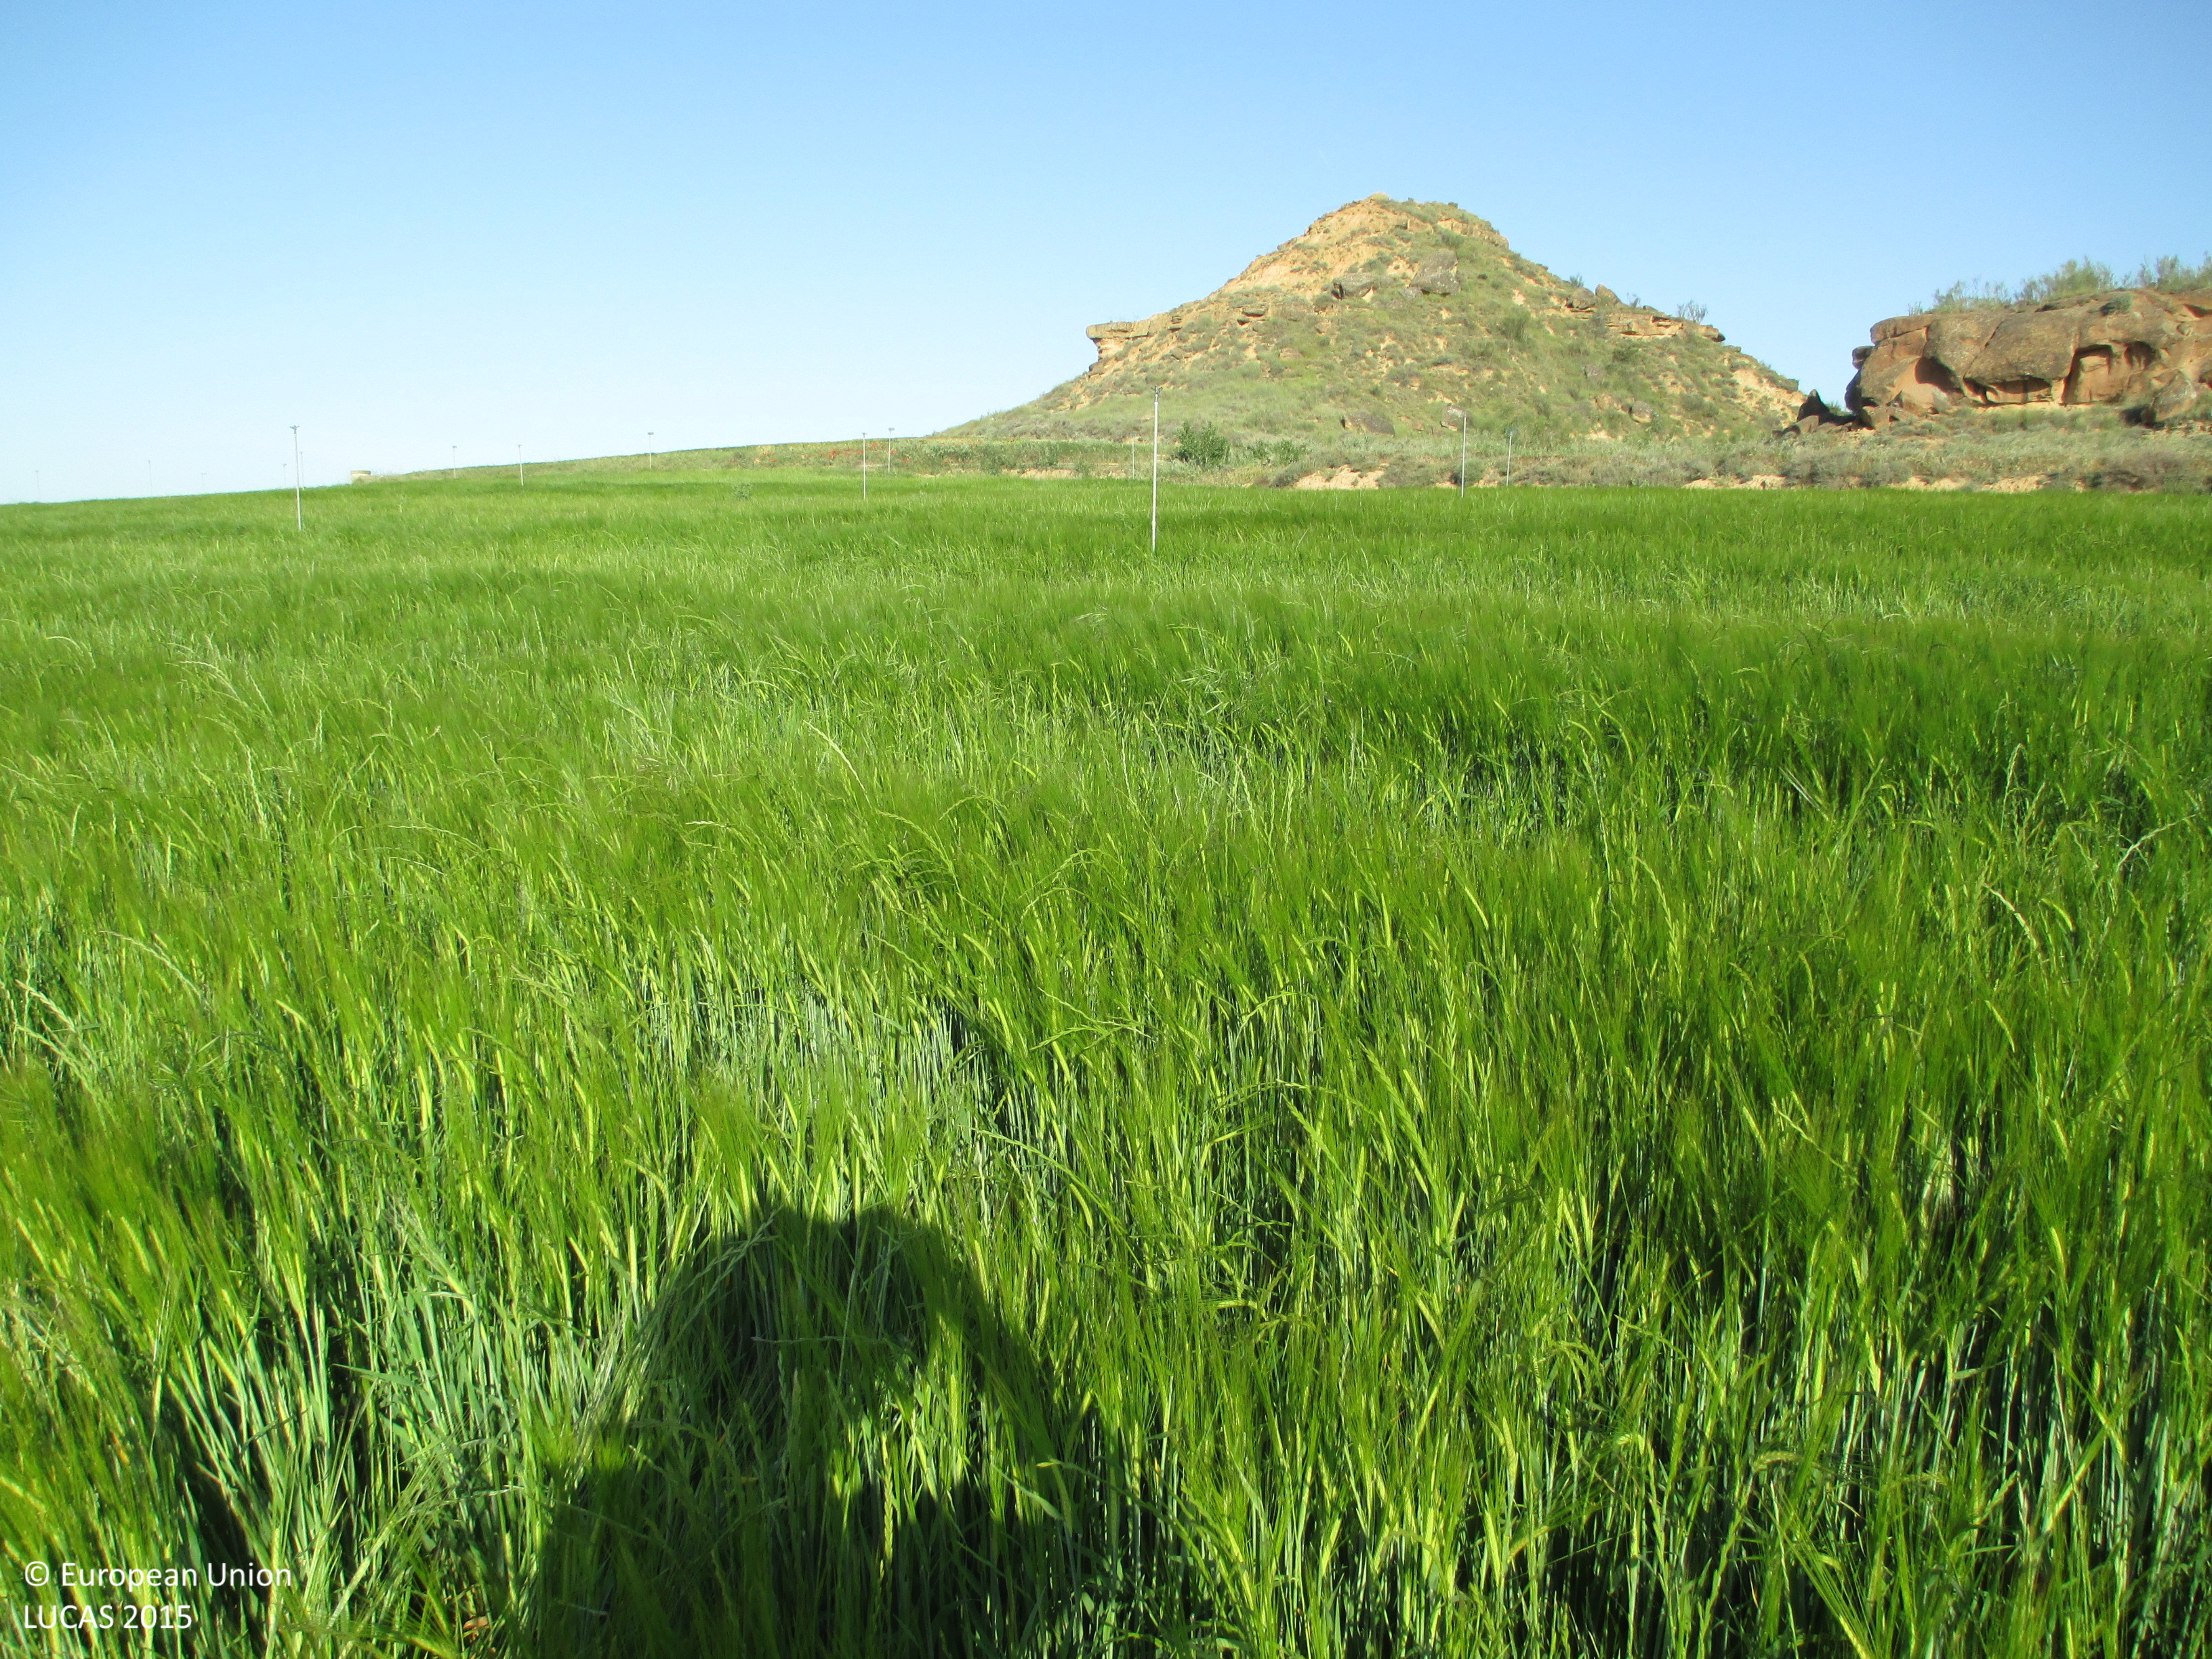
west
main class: Cropland
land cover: Barley
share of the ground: > 75 %
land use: Agriculture (excluding fallow land and kitchen gardens)
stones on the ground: < 10 %
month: May
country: ES
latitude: 41.9730
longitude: -0.3872
